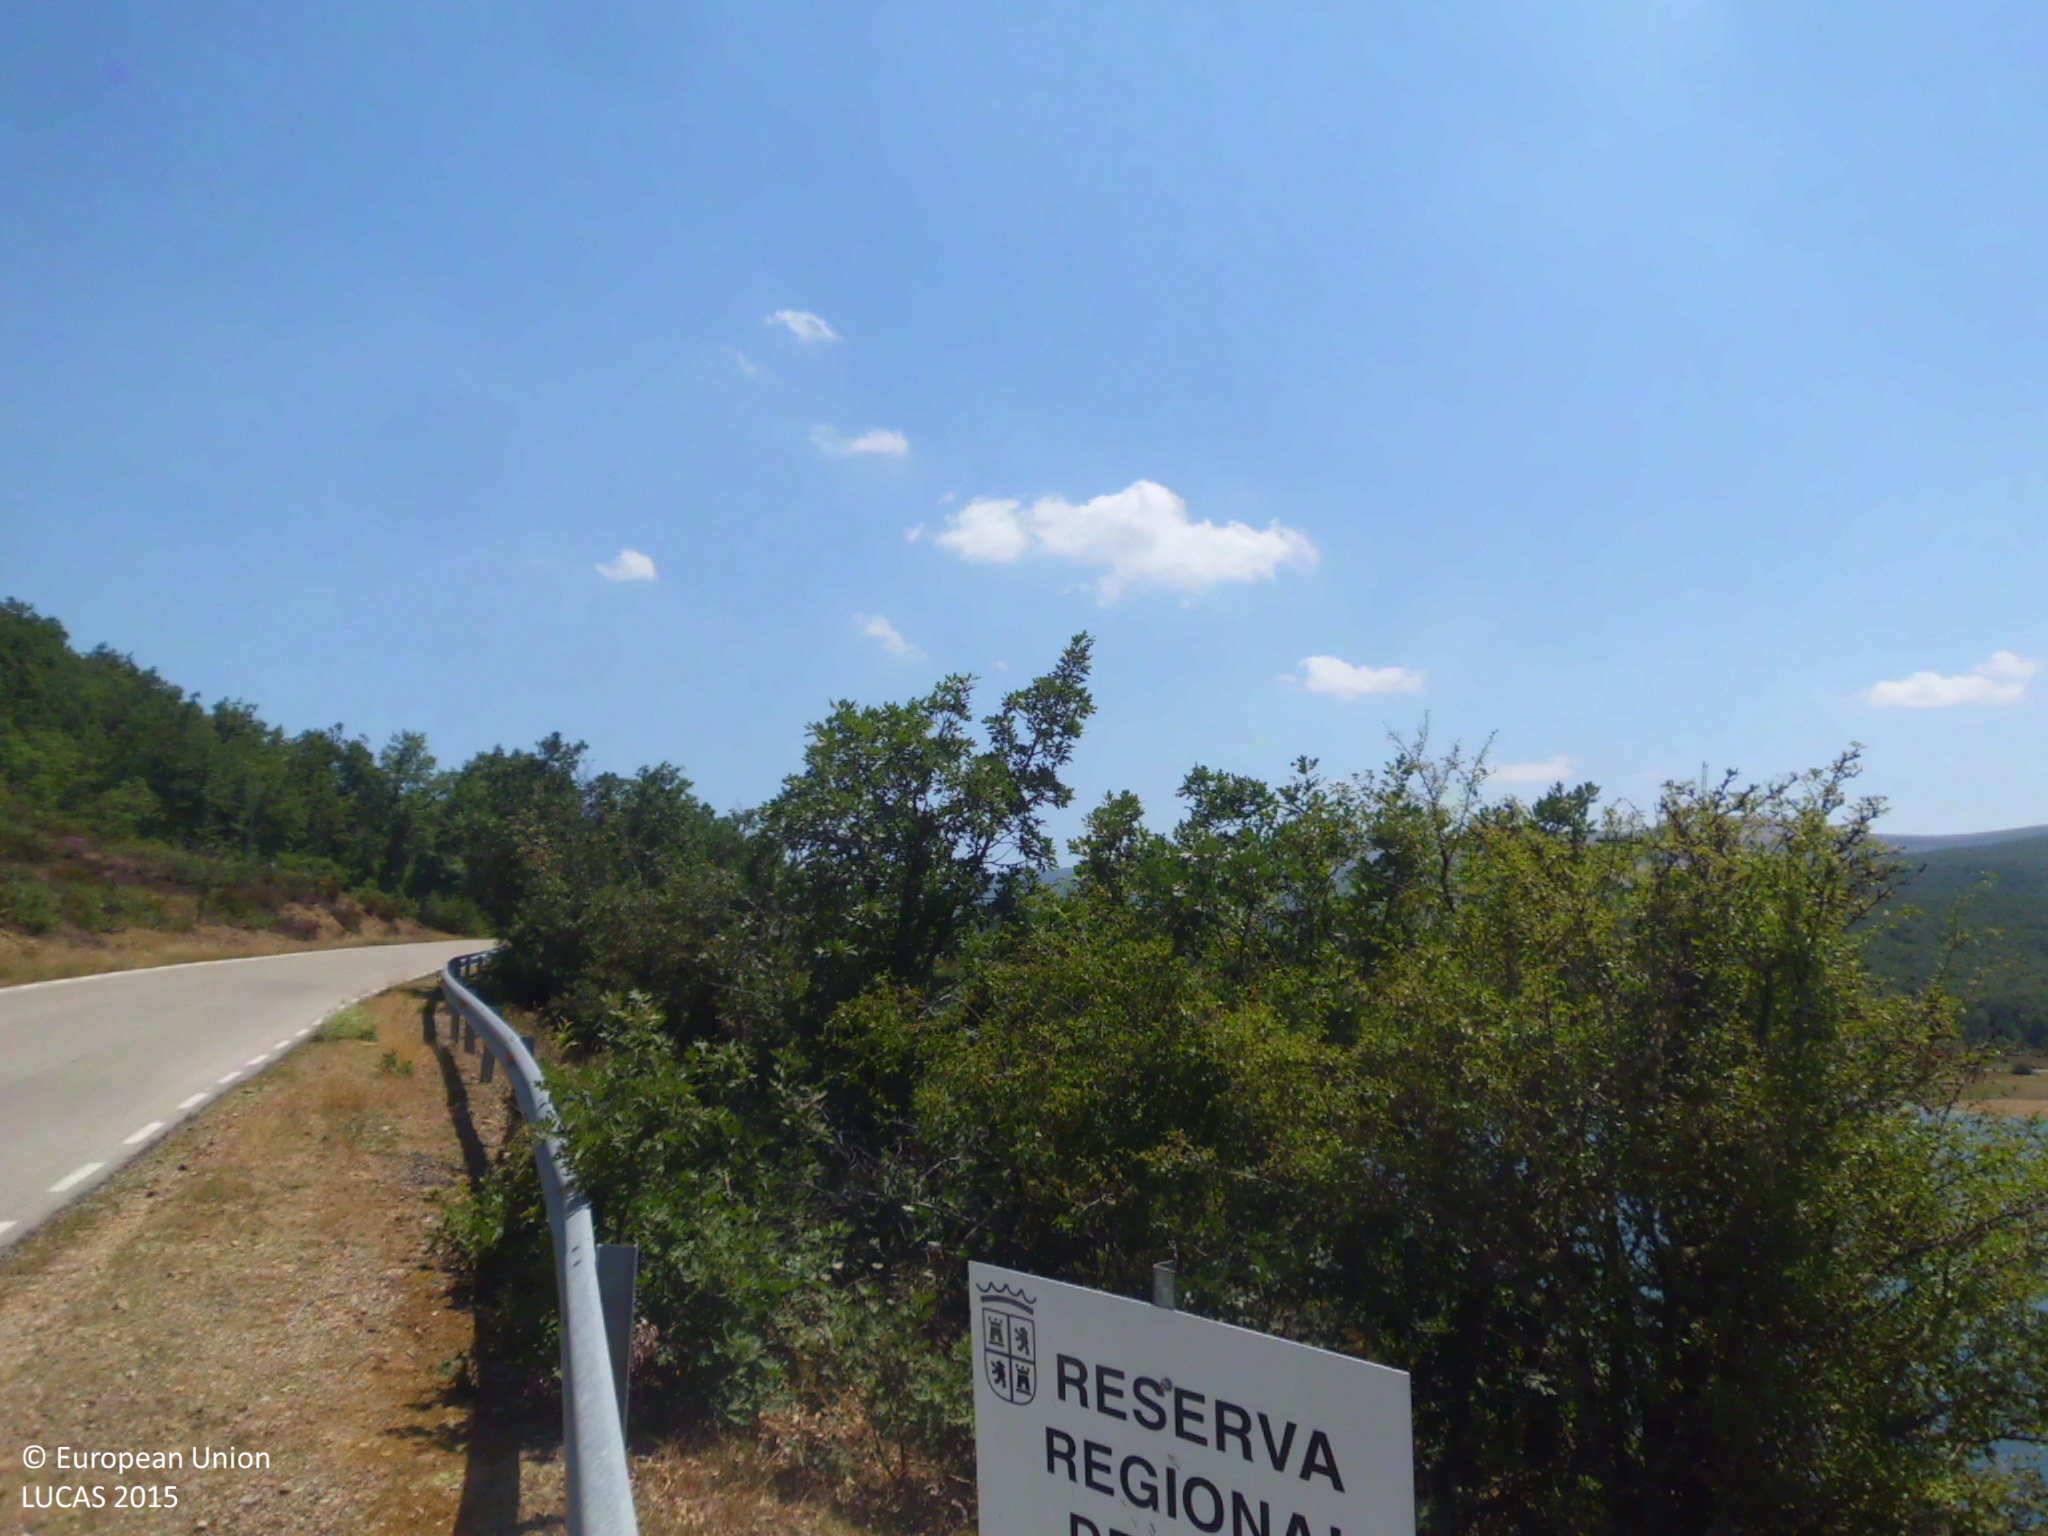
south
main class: Woodland
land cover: Pine dominated coniferous woodland
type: coniferous forest of the mediterranean region
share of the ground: > 75 %
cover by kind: coniferous forest trees 100 %
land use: Forestry
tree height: > 5 m
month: July
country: ES
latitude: 42.2413
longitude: -3.3485
